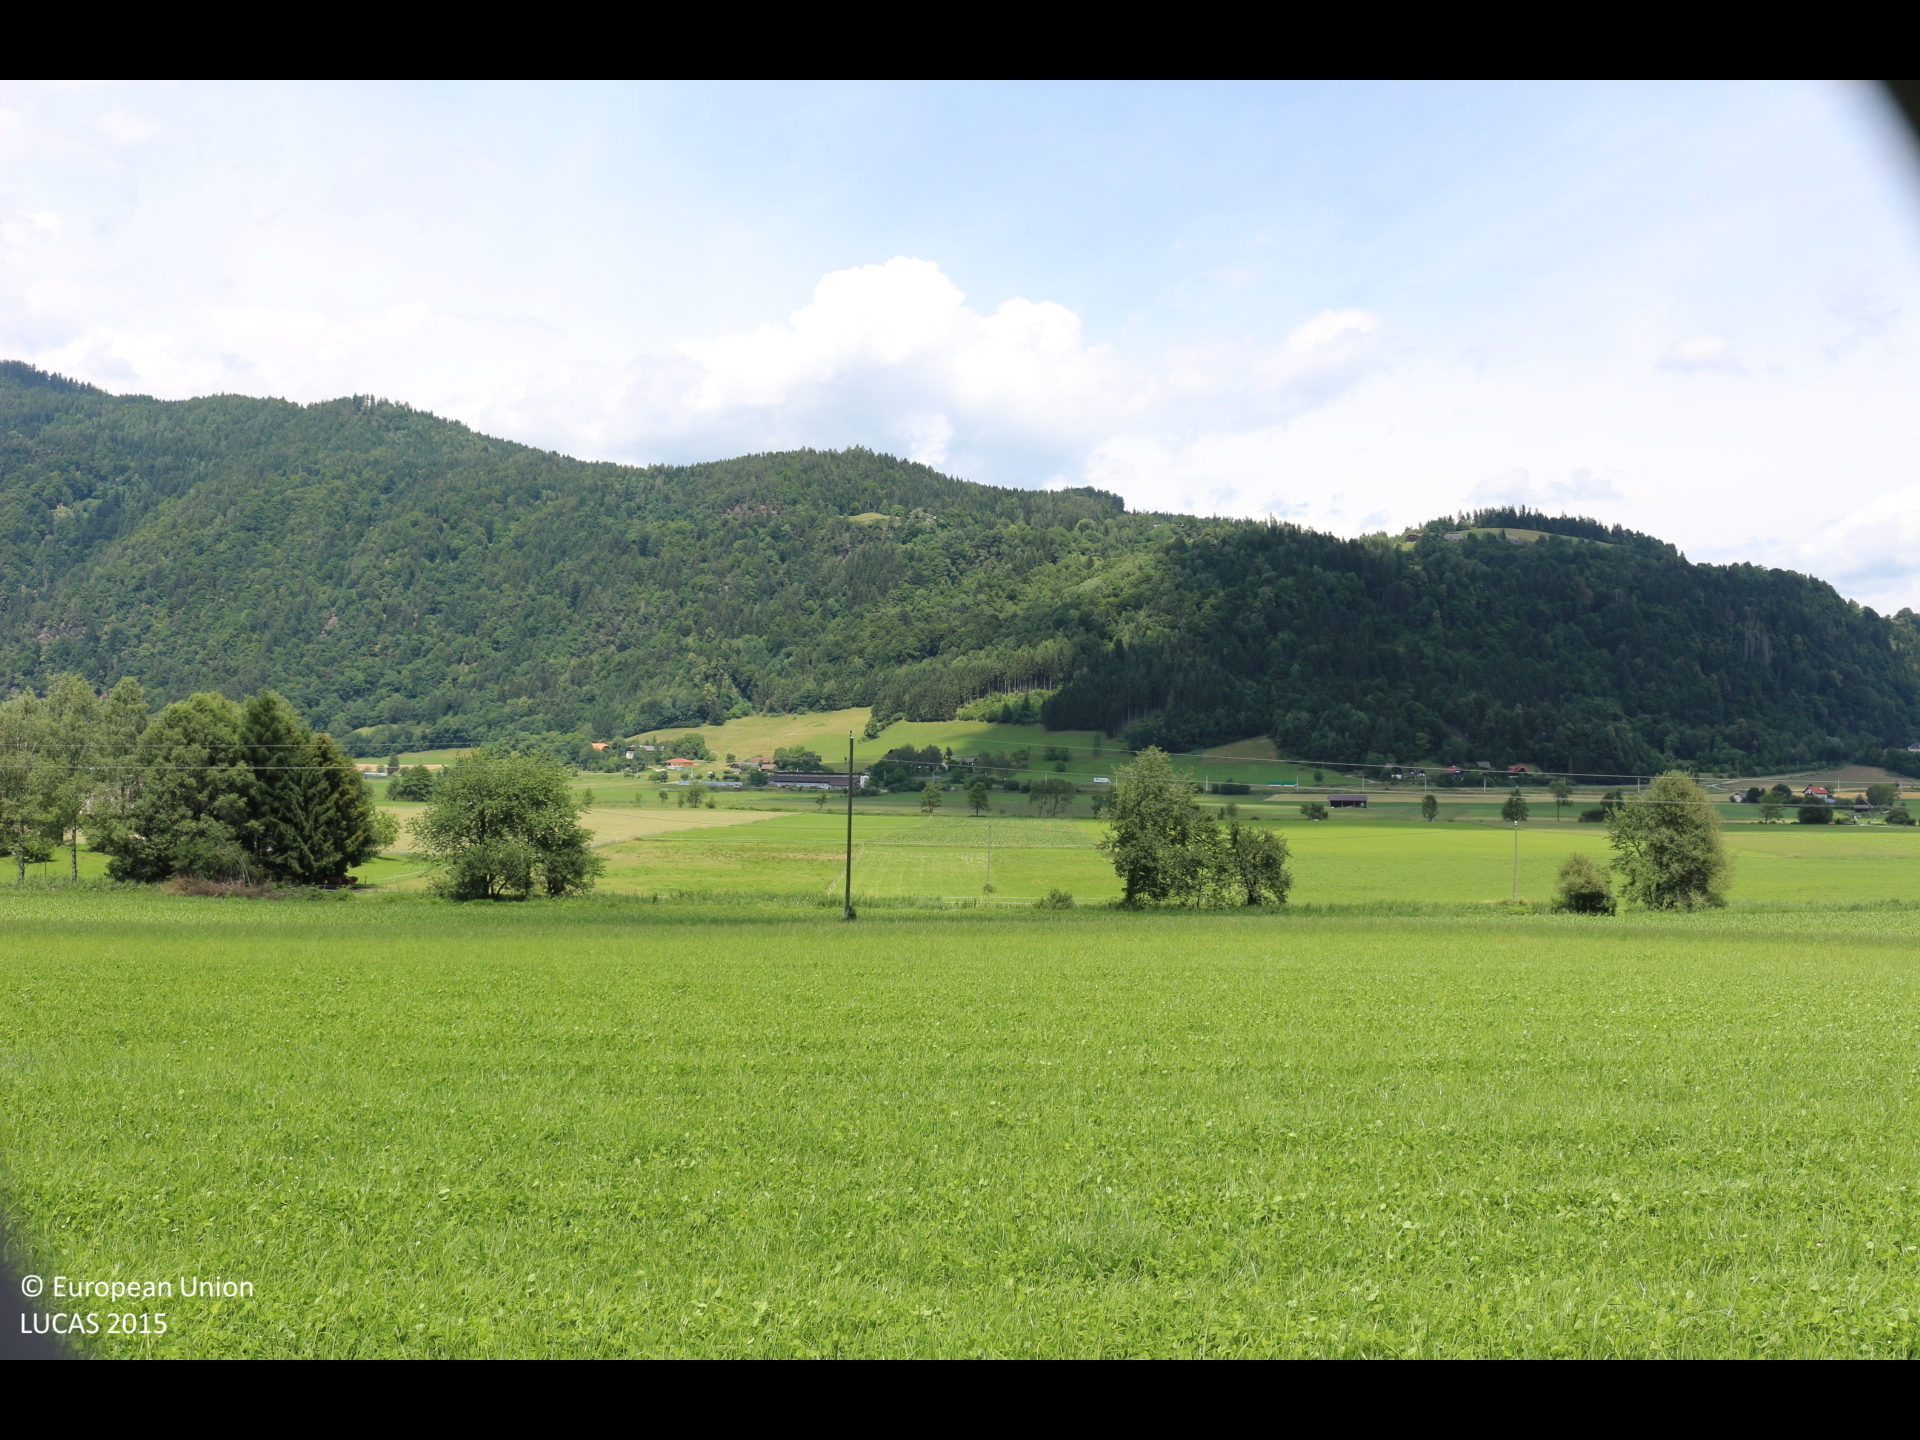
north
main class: Cropland
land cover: Temporary grasslands
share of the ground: > 75 %
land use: Agriculture (excluding fallow land and kitchen gardens)
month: June
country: AT
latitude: 46.6897
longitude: 14.0378
